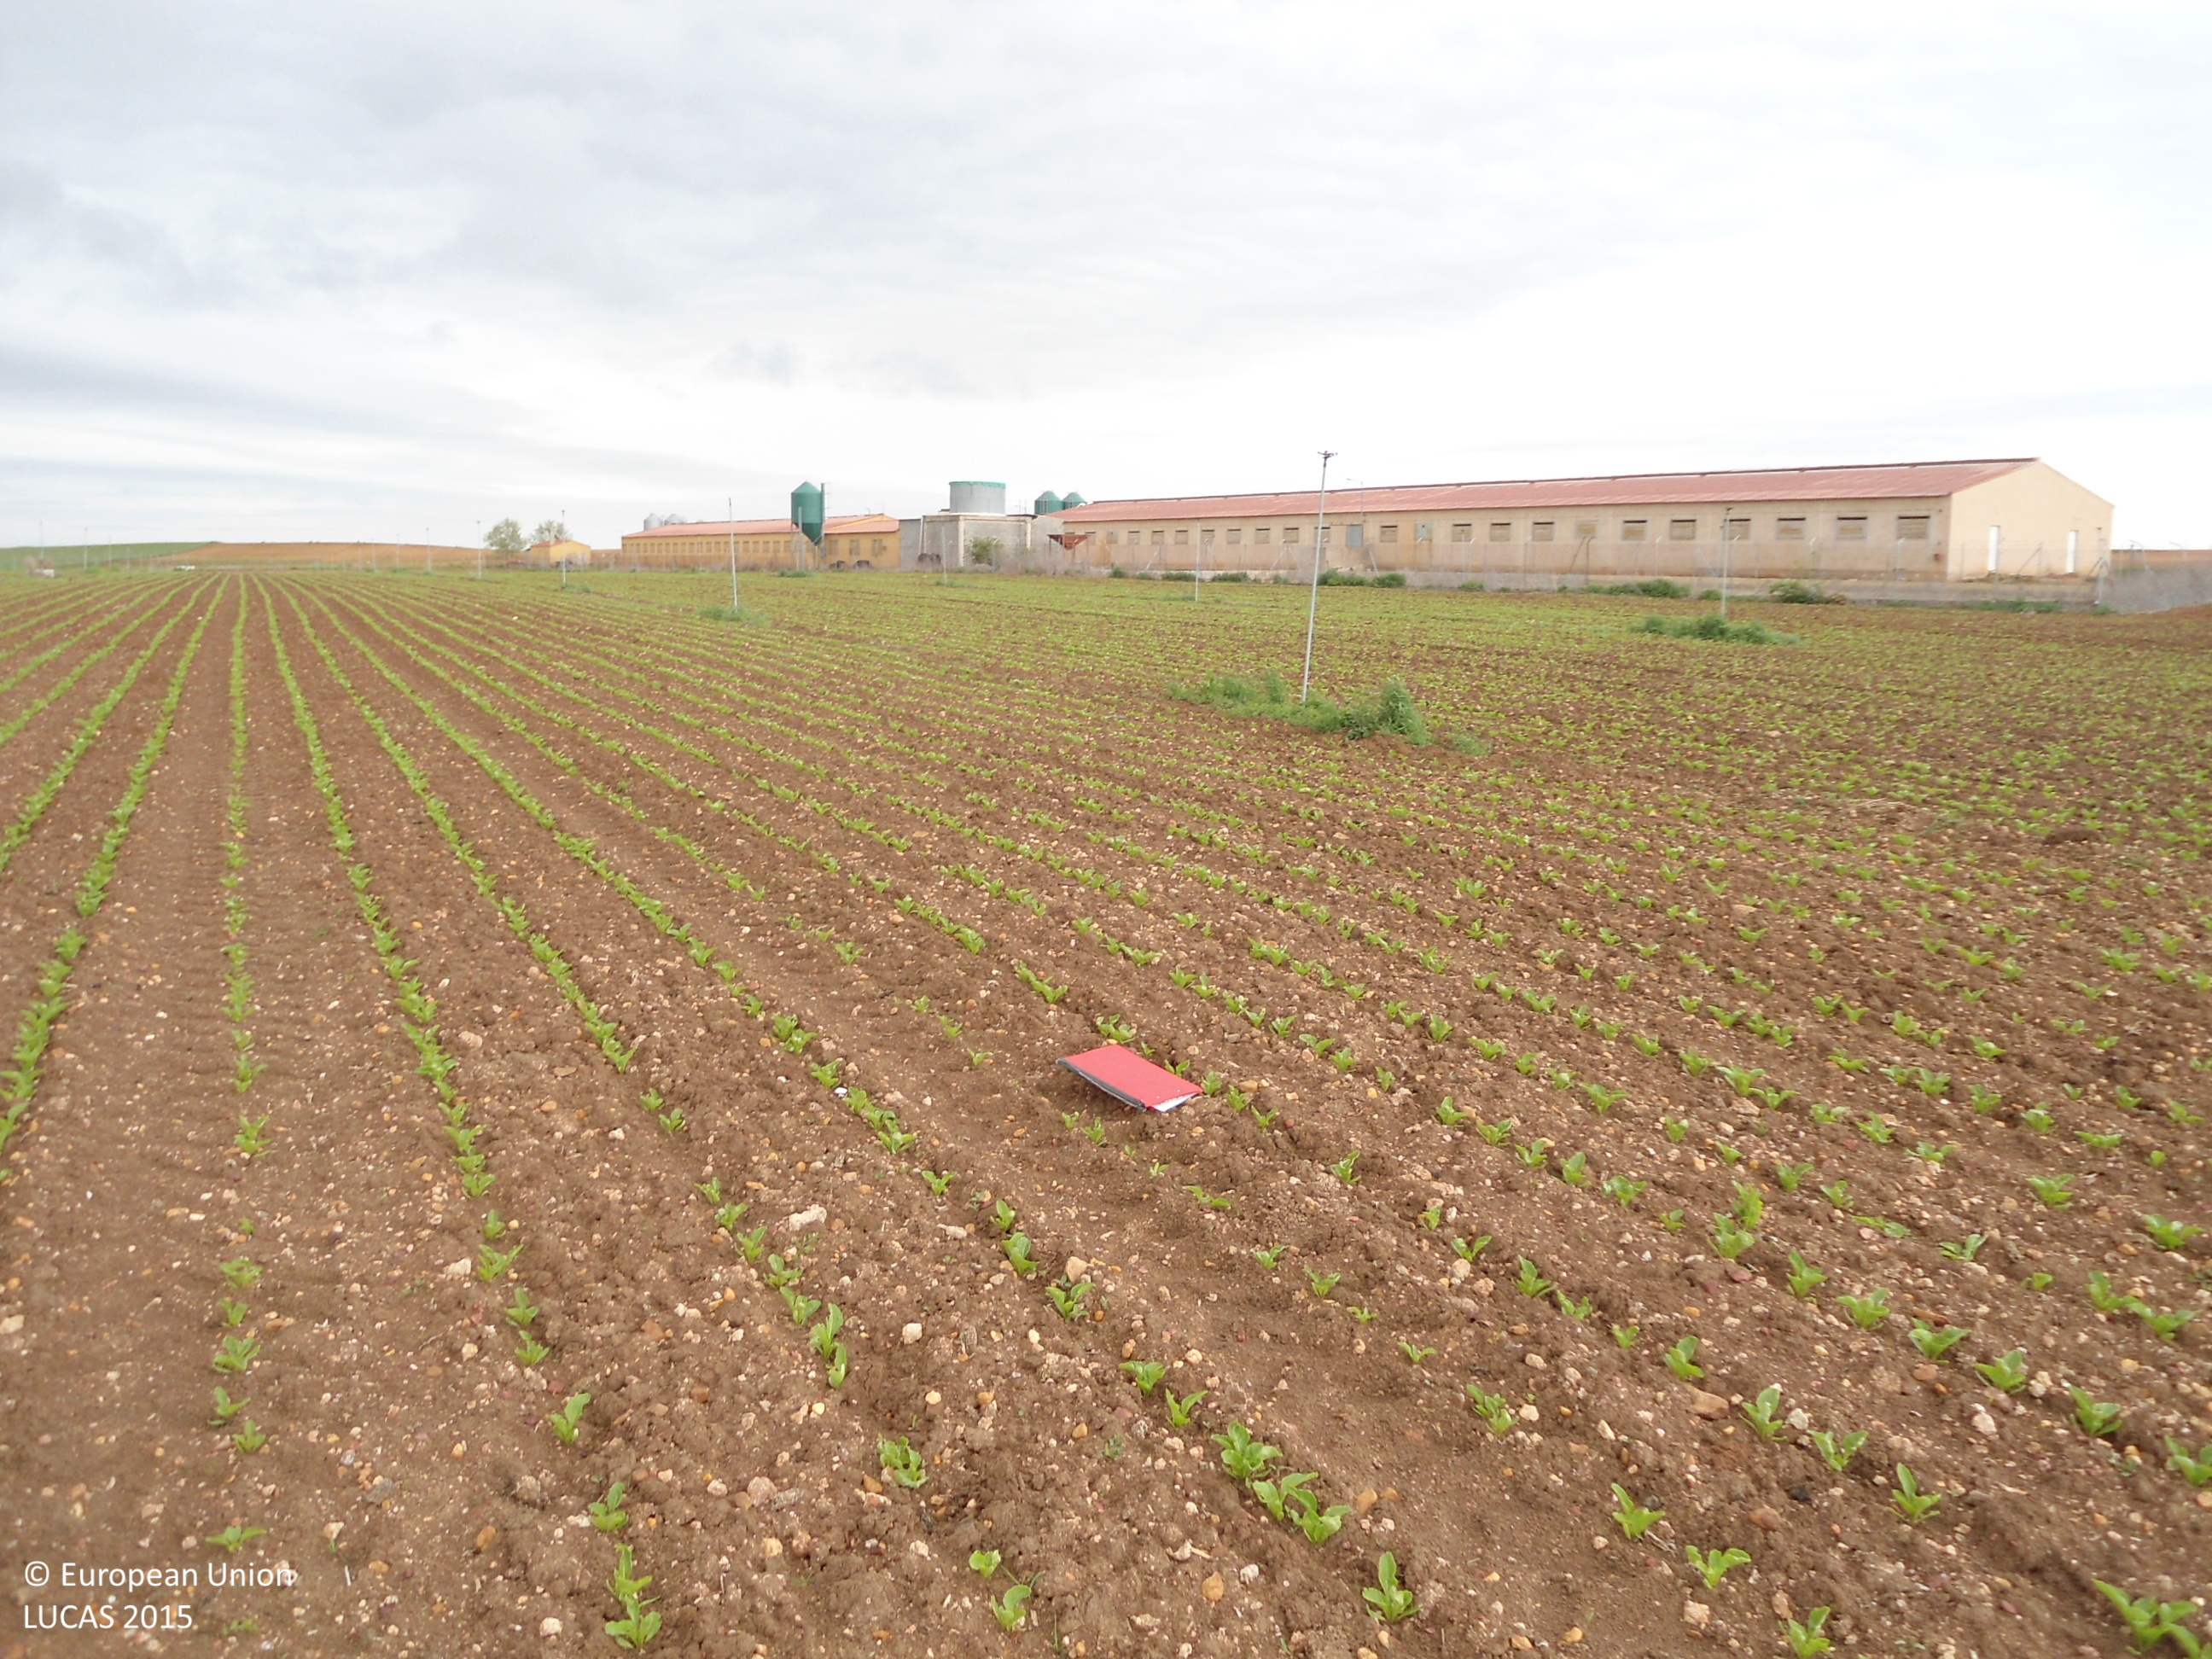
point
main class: Cropland
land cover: Sugar beet
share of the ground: 25 - 50 %
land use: Agriculture (excluding fallow land and kitchen gardens)
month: May
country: ES
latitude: 41.7800
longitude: -5.8660
